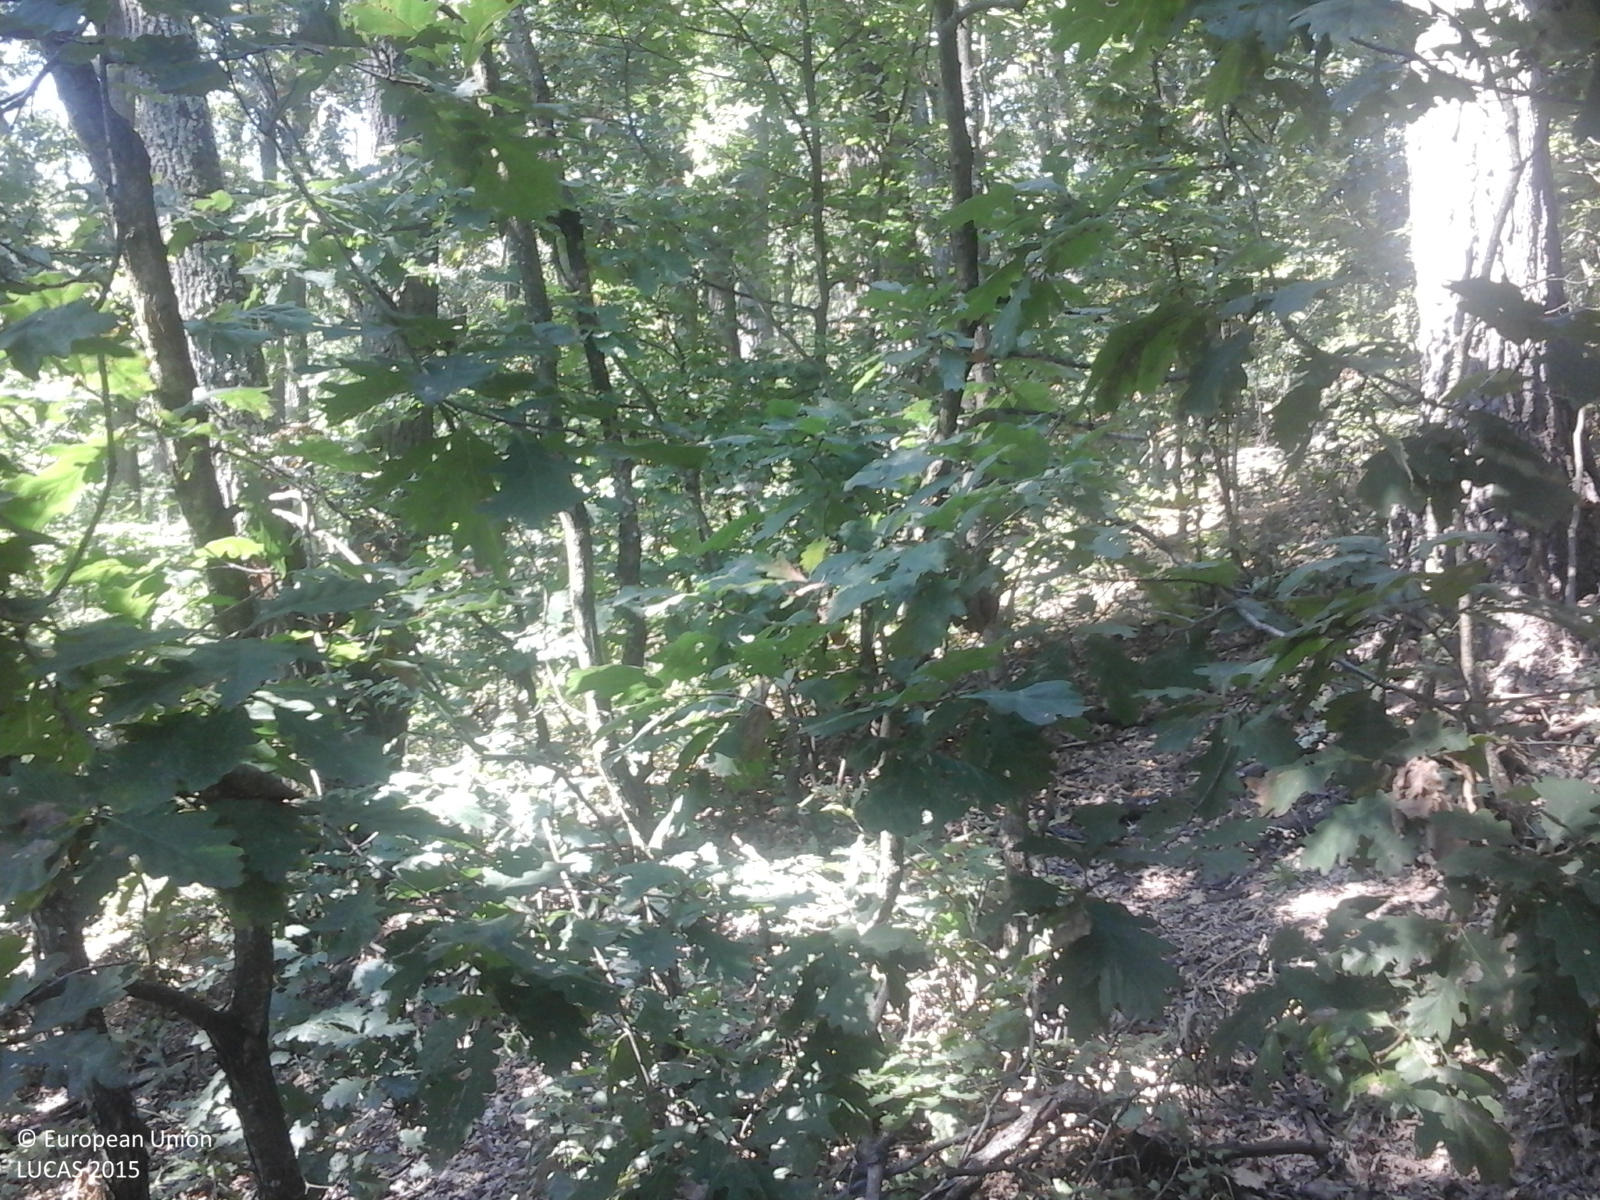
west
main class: Woodland
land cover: Broadleaved woodland
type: acidophilous oak and oak-birch forest
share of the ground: > 75 %
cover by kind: broadleaved forest trees 100 %
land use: Forestry
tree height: > 5 m
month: September
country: RO
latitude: 47.3930
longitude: 22.7120
